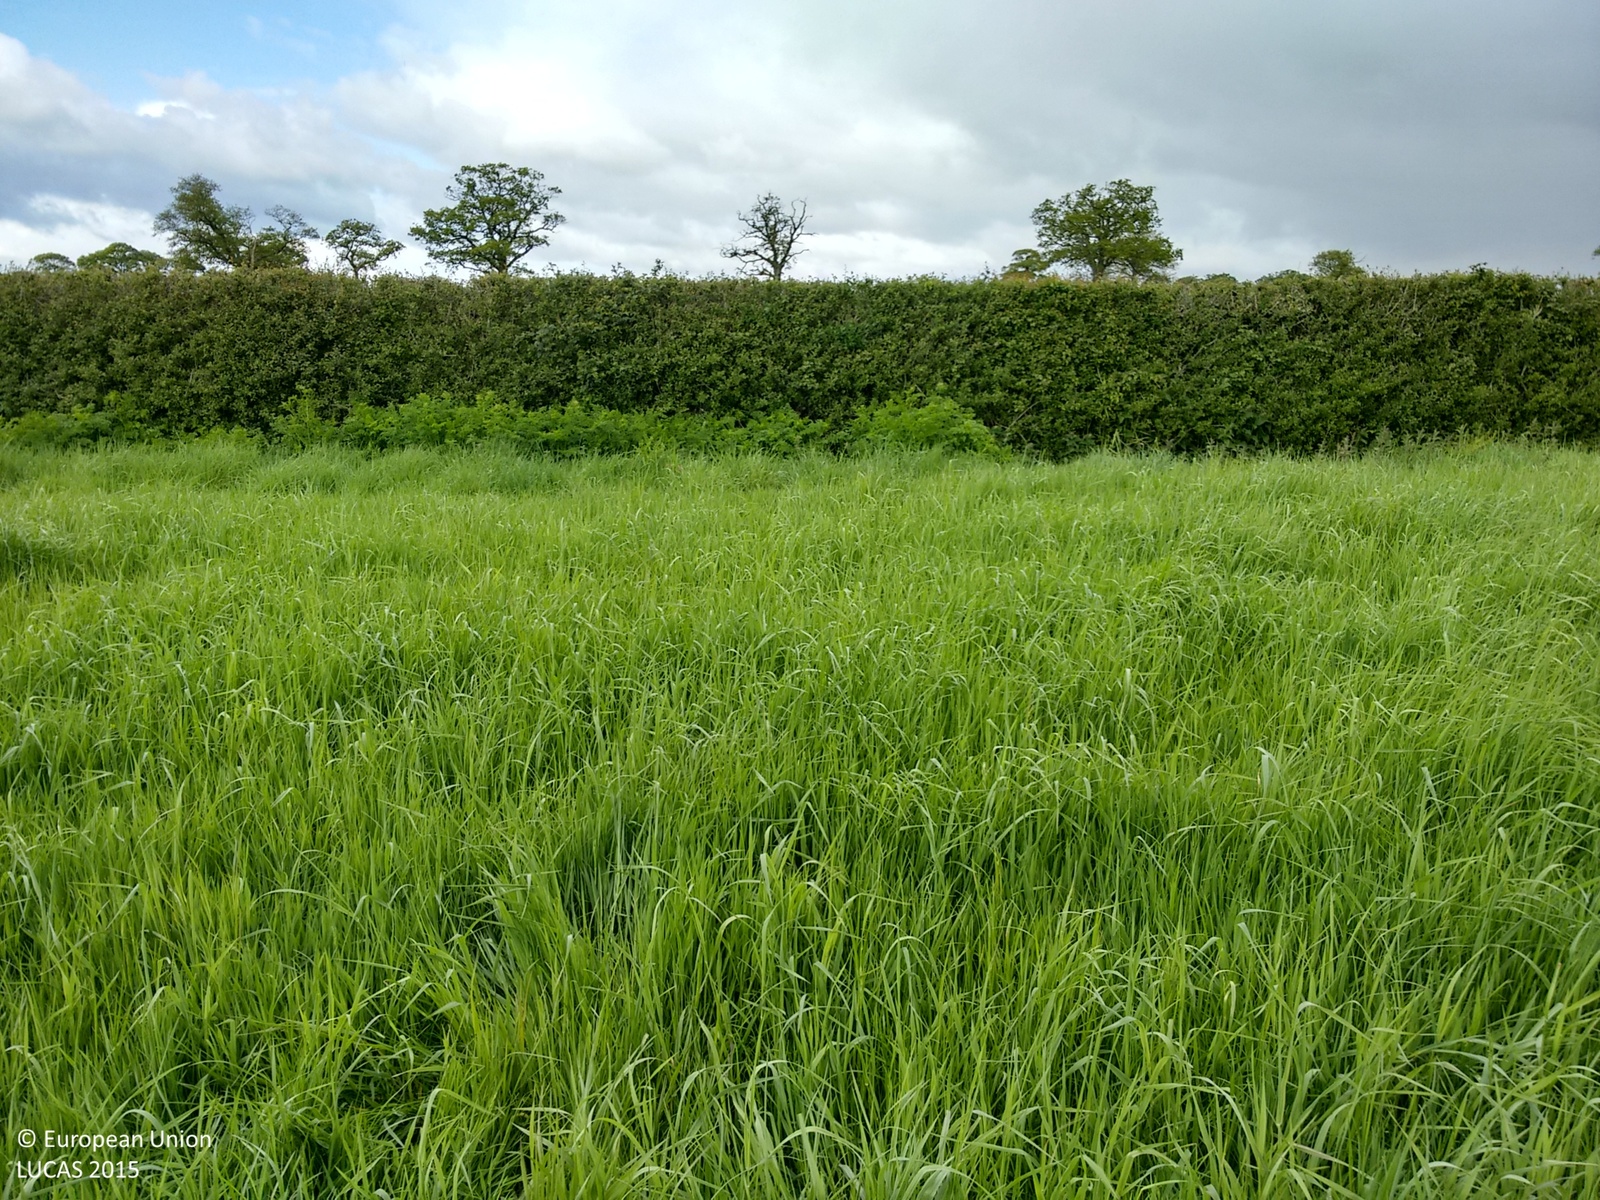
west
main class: Cropland
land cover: Temporary grasslands
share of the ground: > 75 %
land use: Agriculture (excluding fallow land and kitchen gardens)
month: May
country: GB
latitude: 50.9060
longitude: -2.3940
